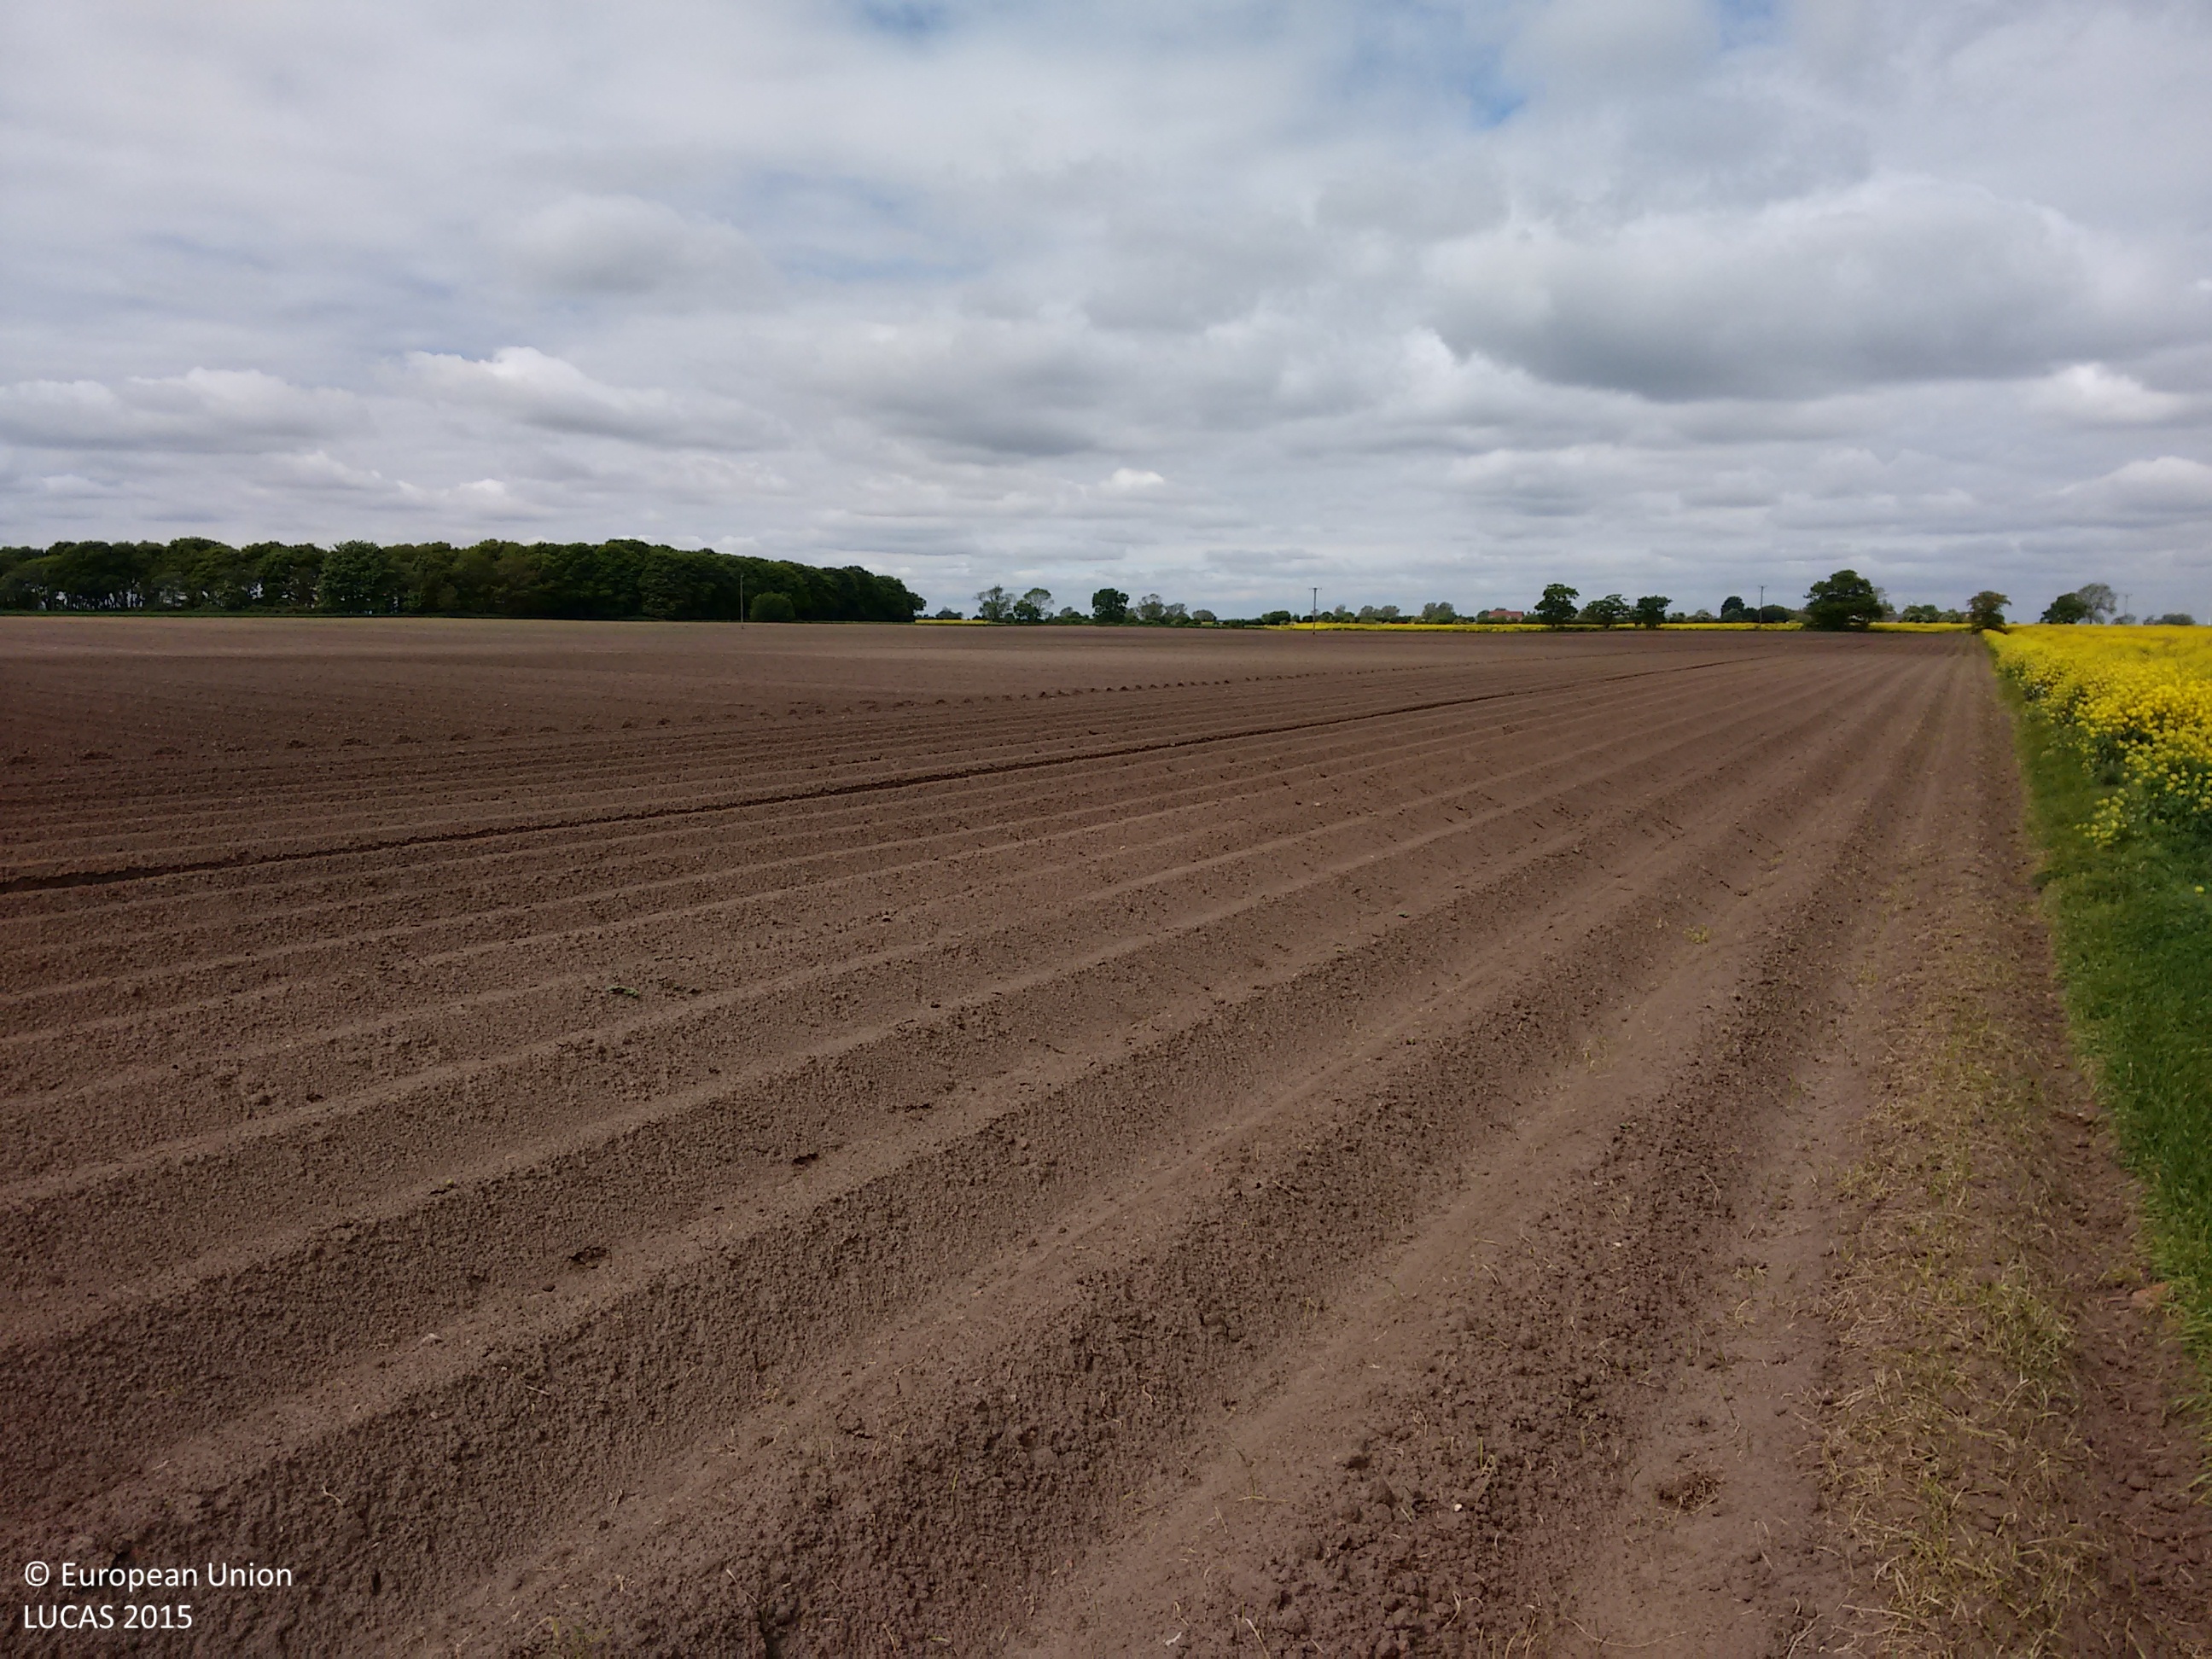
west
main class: Cropland
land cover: Potatoes
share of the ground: < 10 %
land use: Agriculture (excluding fallow land and kitchen gardens)
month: May
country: GB
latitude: 53.6259
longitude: -0.7911
